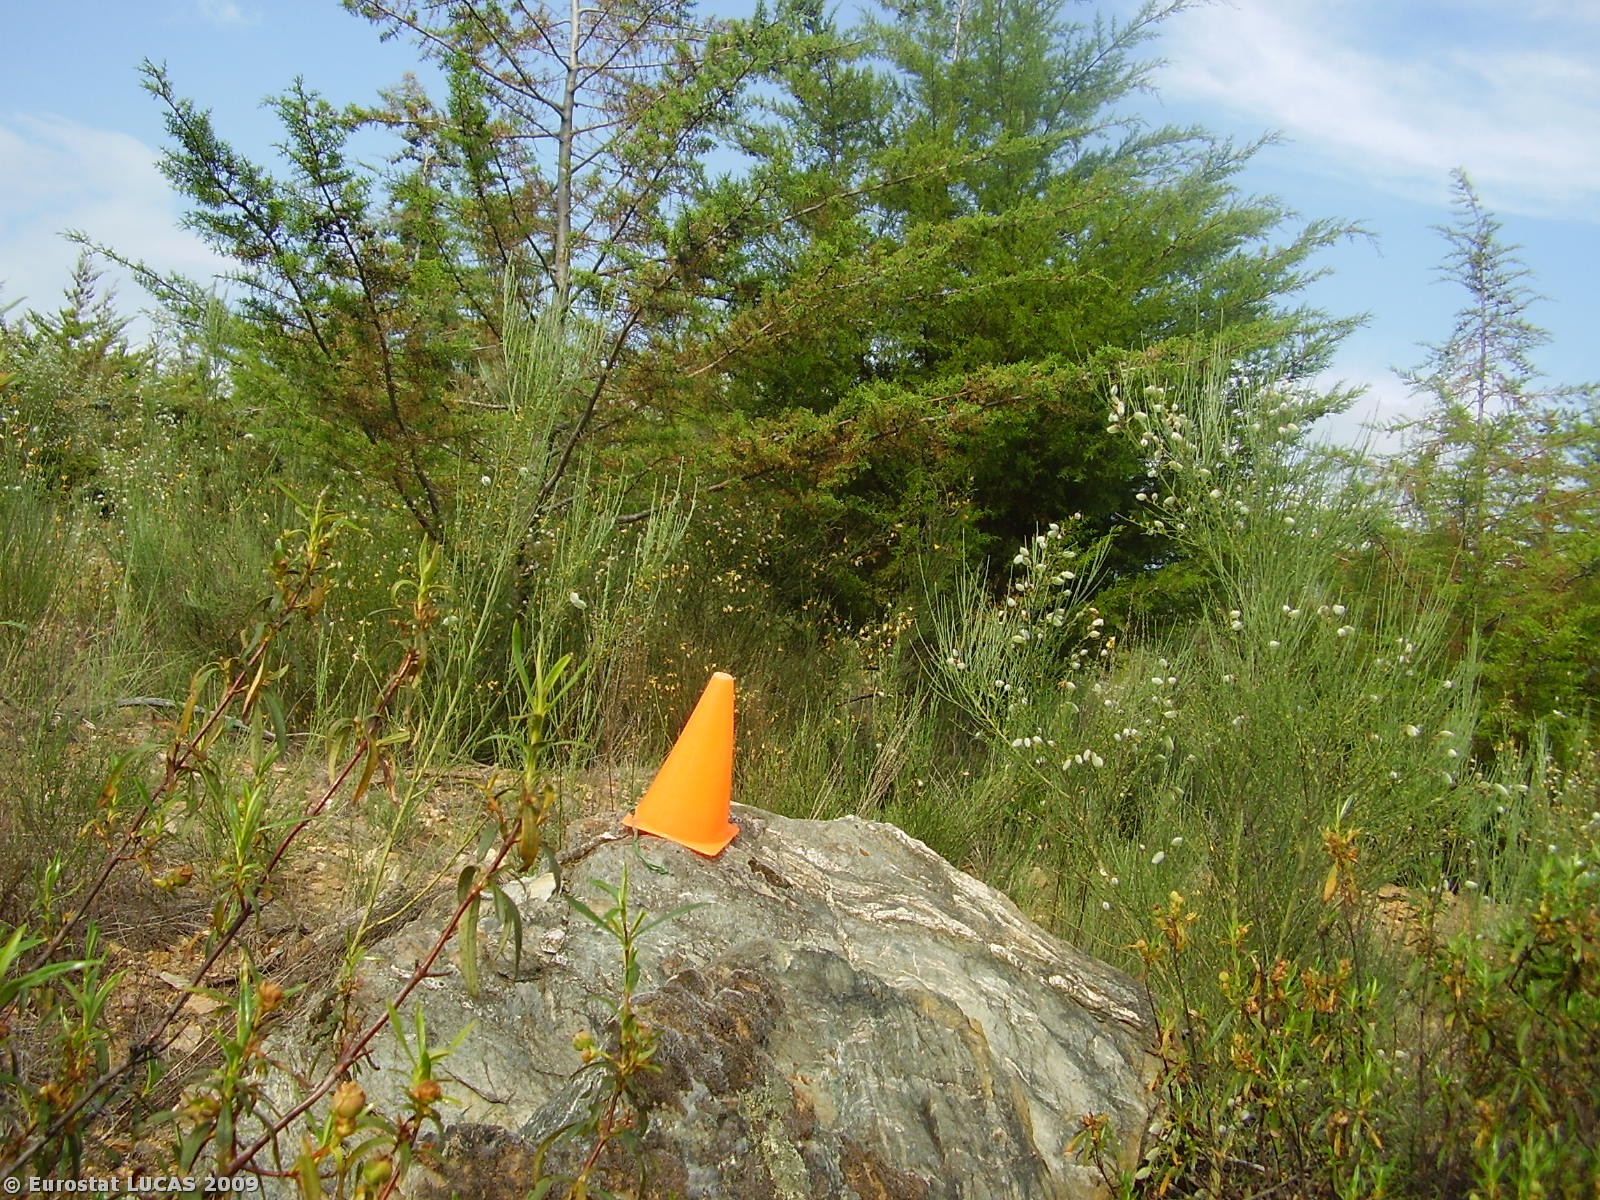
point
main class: Woodland
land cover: Coniferous woodland
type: coniferous forest of the mediterranean region
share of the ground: < 10 %
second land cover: Shrubland with sparse tree cover
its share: 50 - 75 %
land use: Forestry
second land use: Nature reserves
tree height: > 5 m
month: June
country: PT
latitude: 41.5947
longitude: -6.8726
